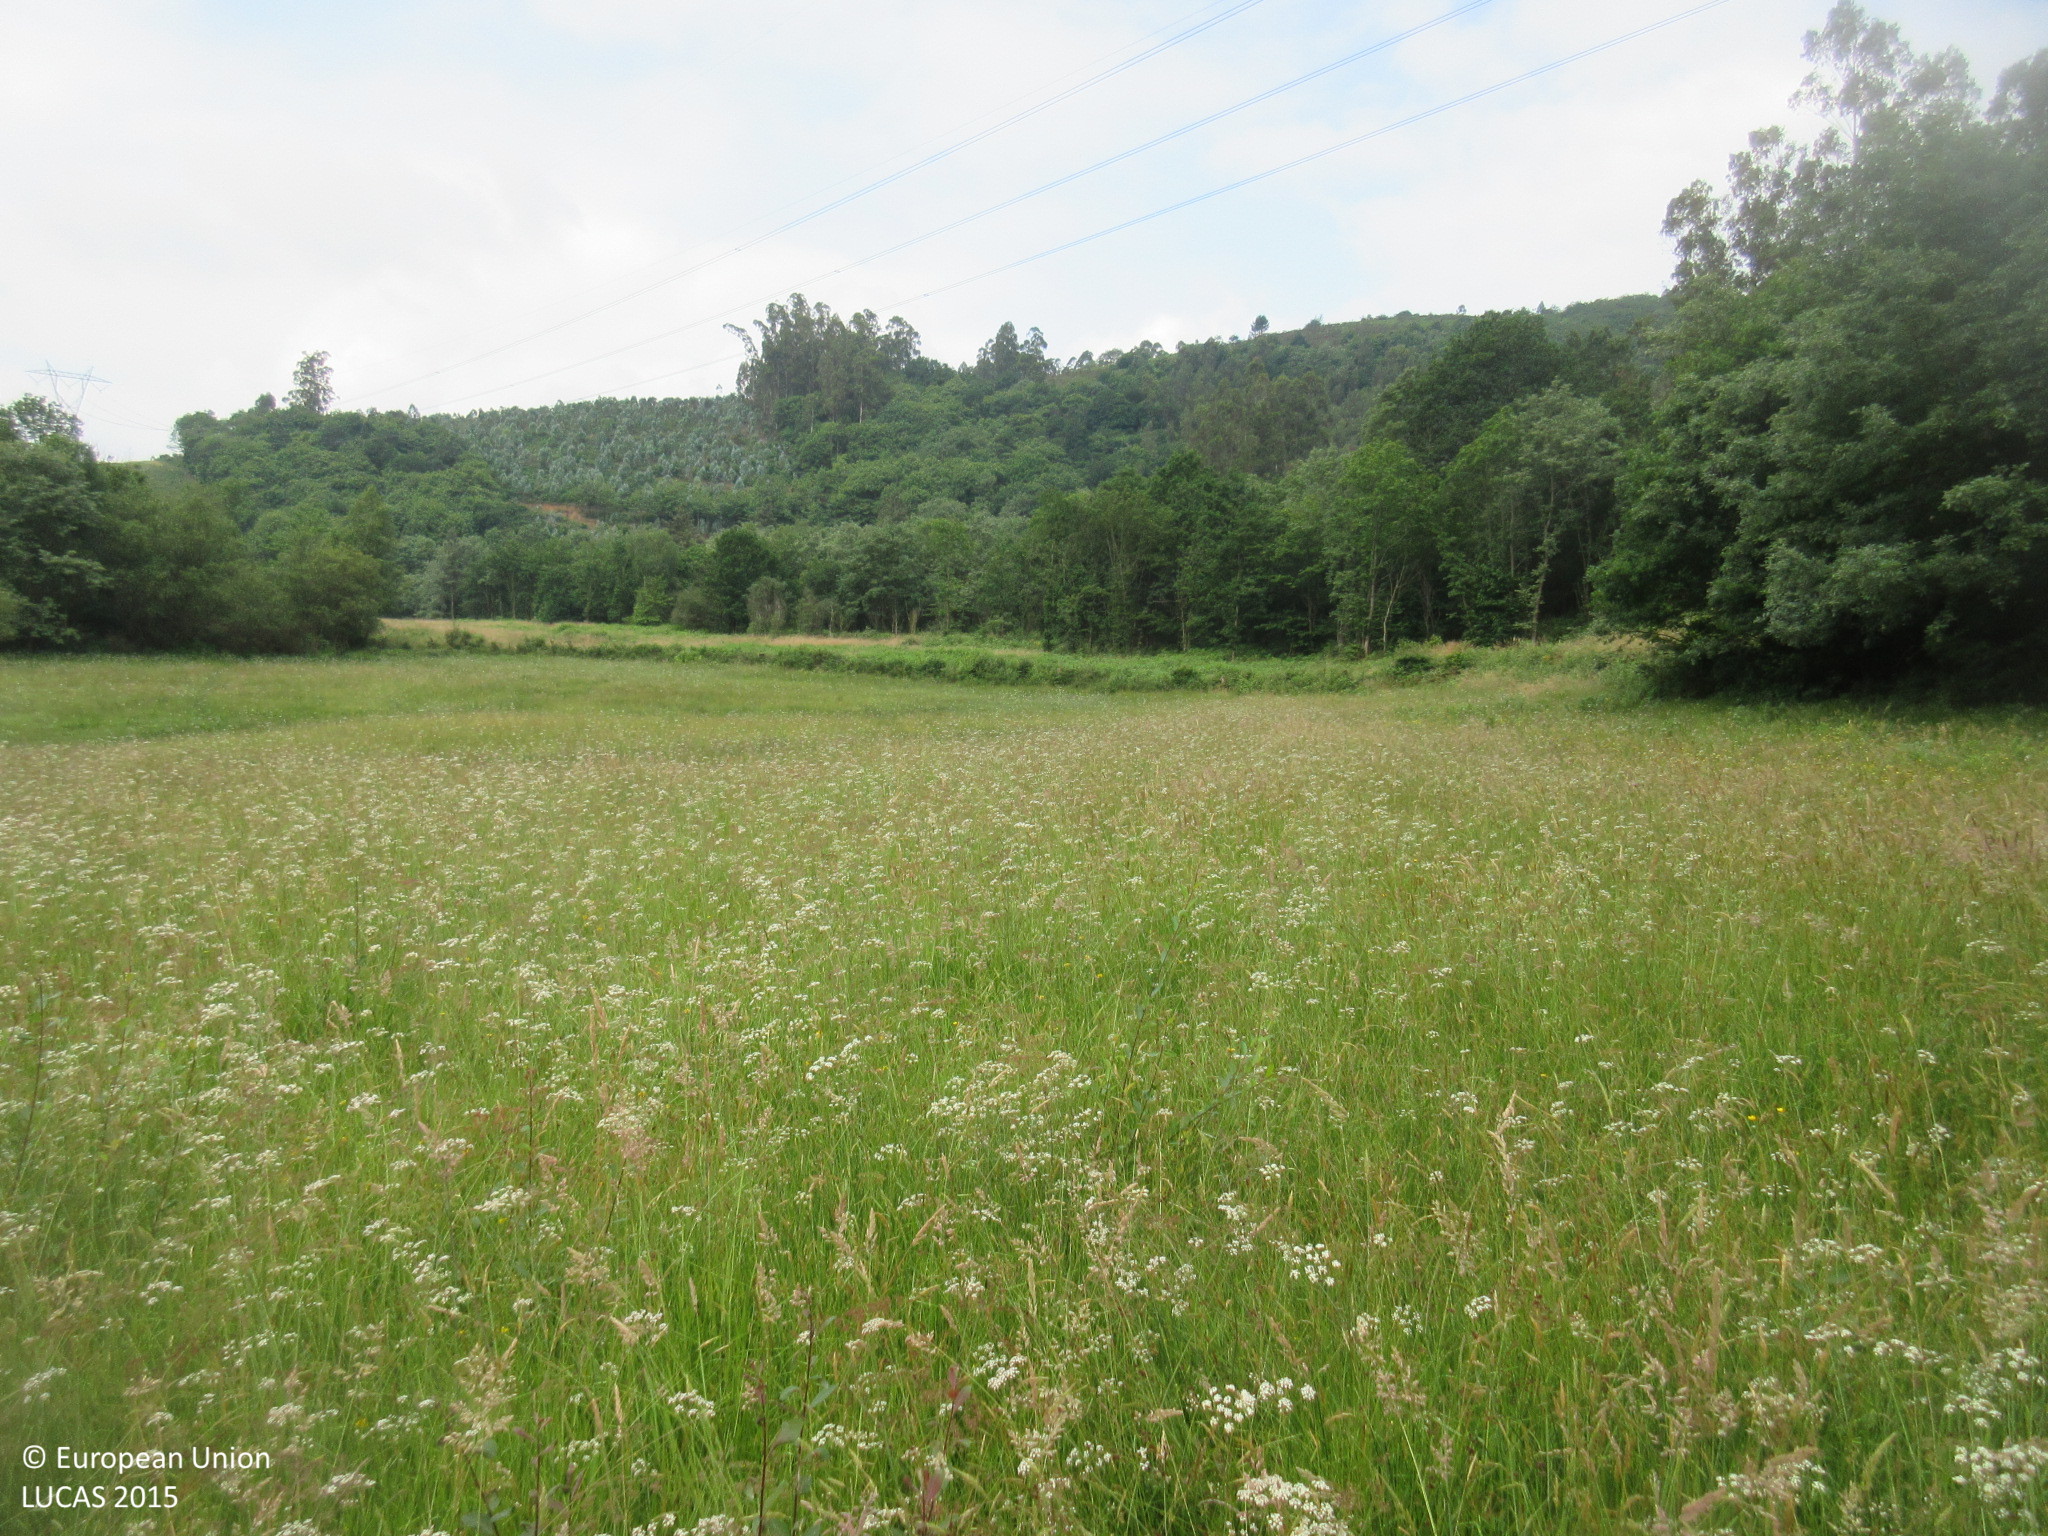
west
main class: Grassland
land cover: Grassland without tree/shrub cover
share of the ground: > 75 %
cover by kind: herbaceous plants 100 %
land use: Agriculture (excluding fallow land and kitchen gardens)
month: June
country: ES
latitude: 43.4038
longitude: -5.9324
